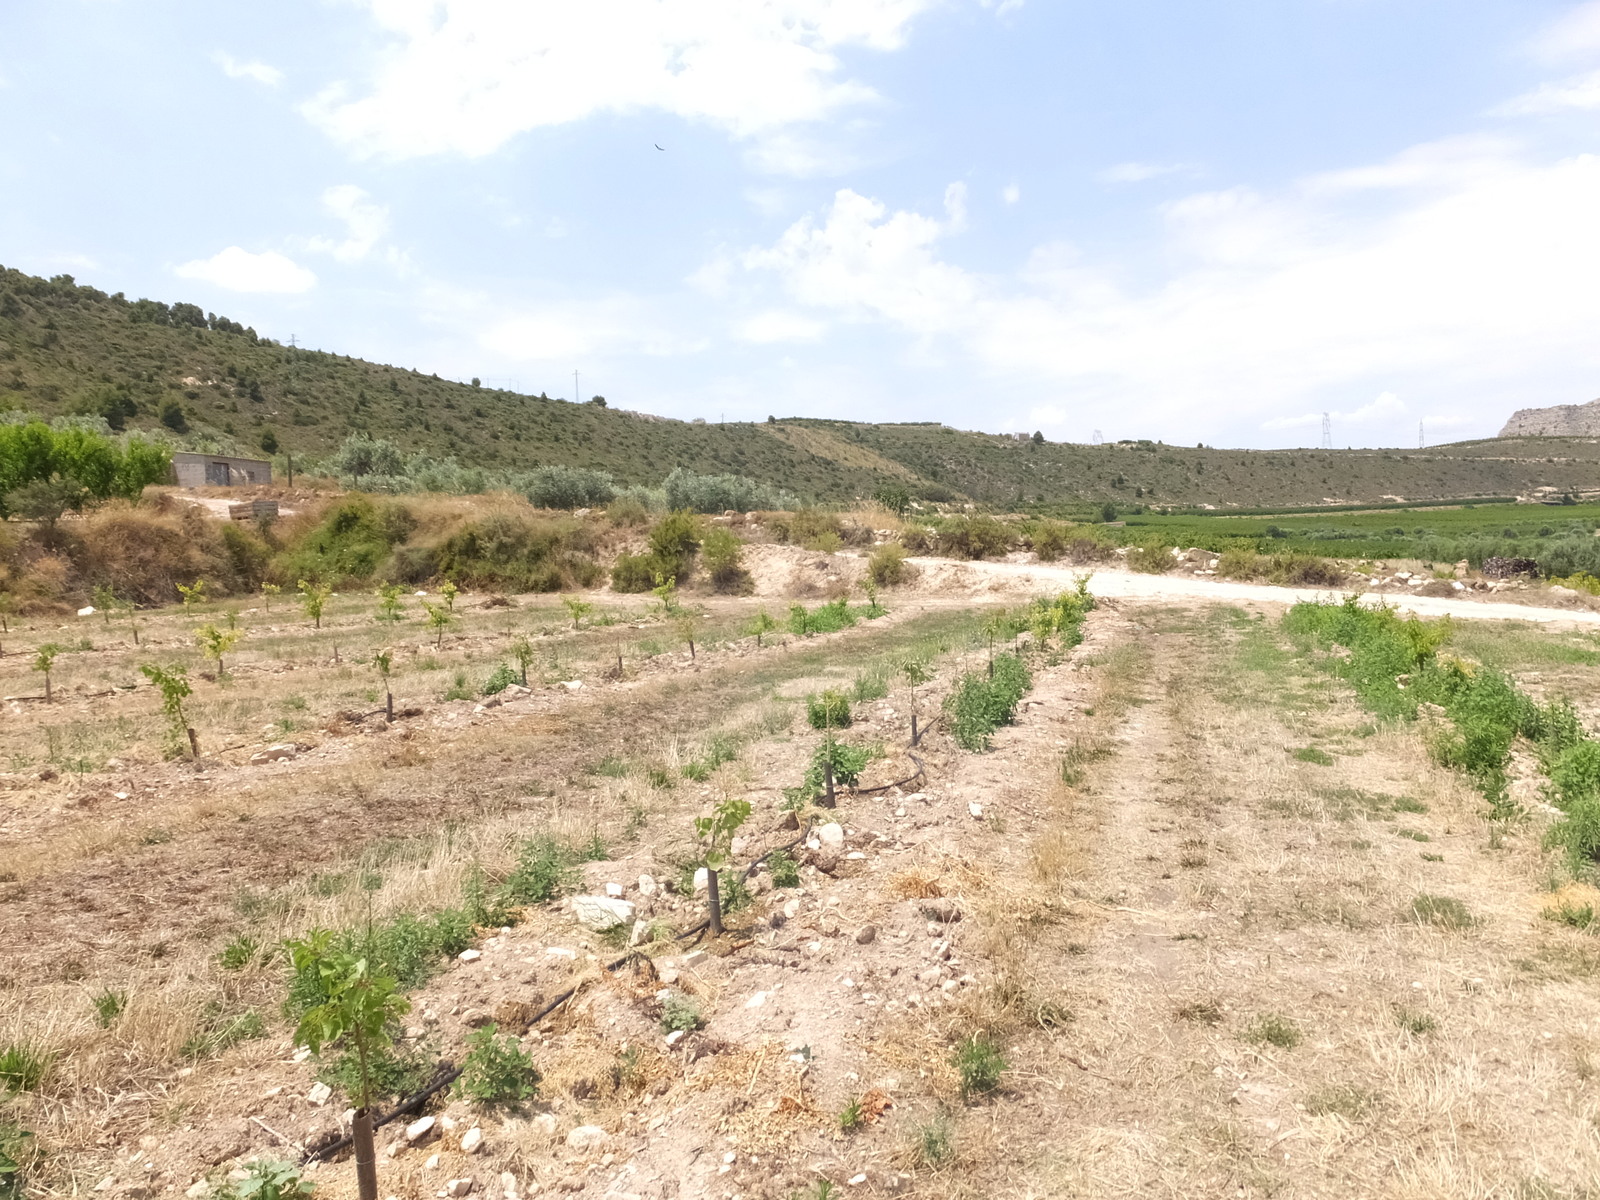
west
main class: Cropland
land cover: Other fruit trees and berries
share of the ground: 10 - 25 %
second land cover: Spontaneously vegetated surfaces
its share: 50 - 75 %
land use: Agriculture (excluding fallow land and kitchen gardens)
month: June
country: ES
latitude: 41.3684
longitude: 0.2923
